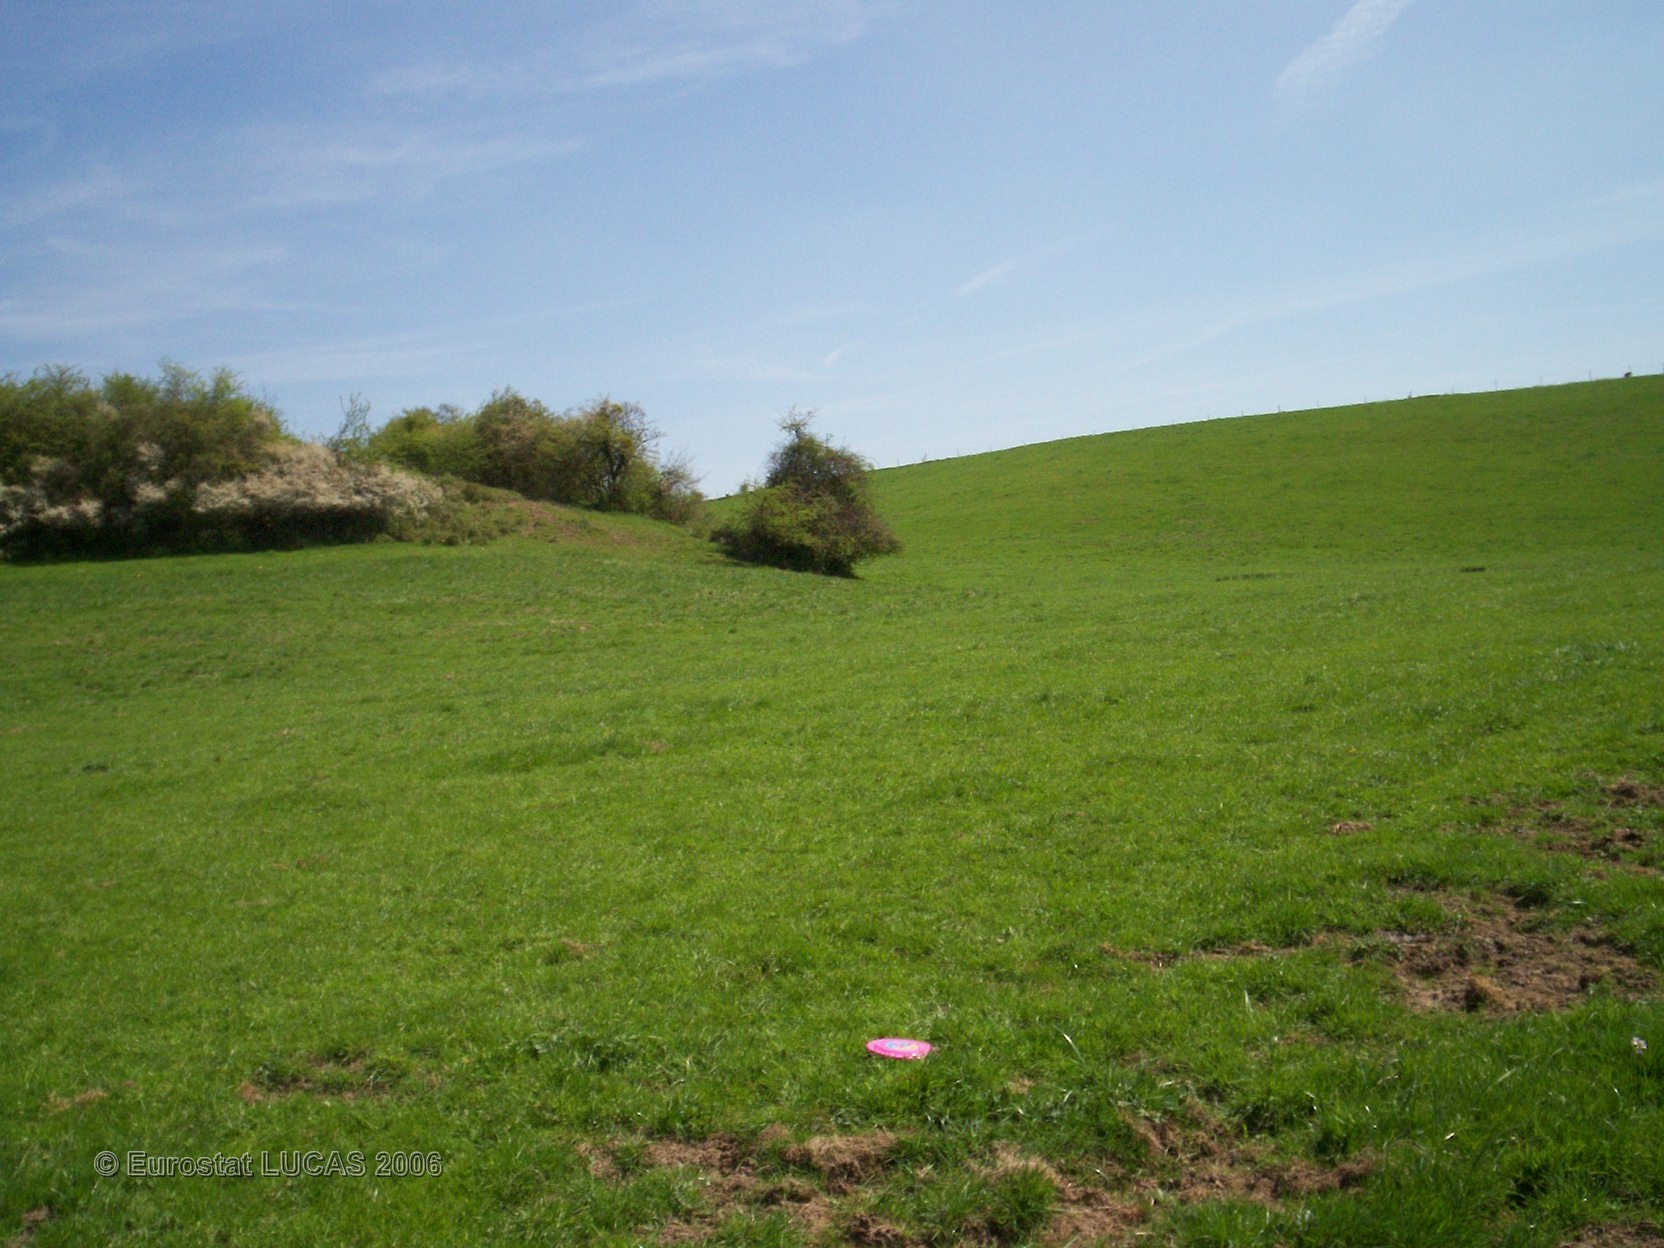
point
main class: Grassland
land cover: Grassland without tree/shrub cover
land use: Agriculture (excluding fallow land and kitchen gardens)
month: April
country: FR
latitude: 49.6466
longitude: 4.3312
